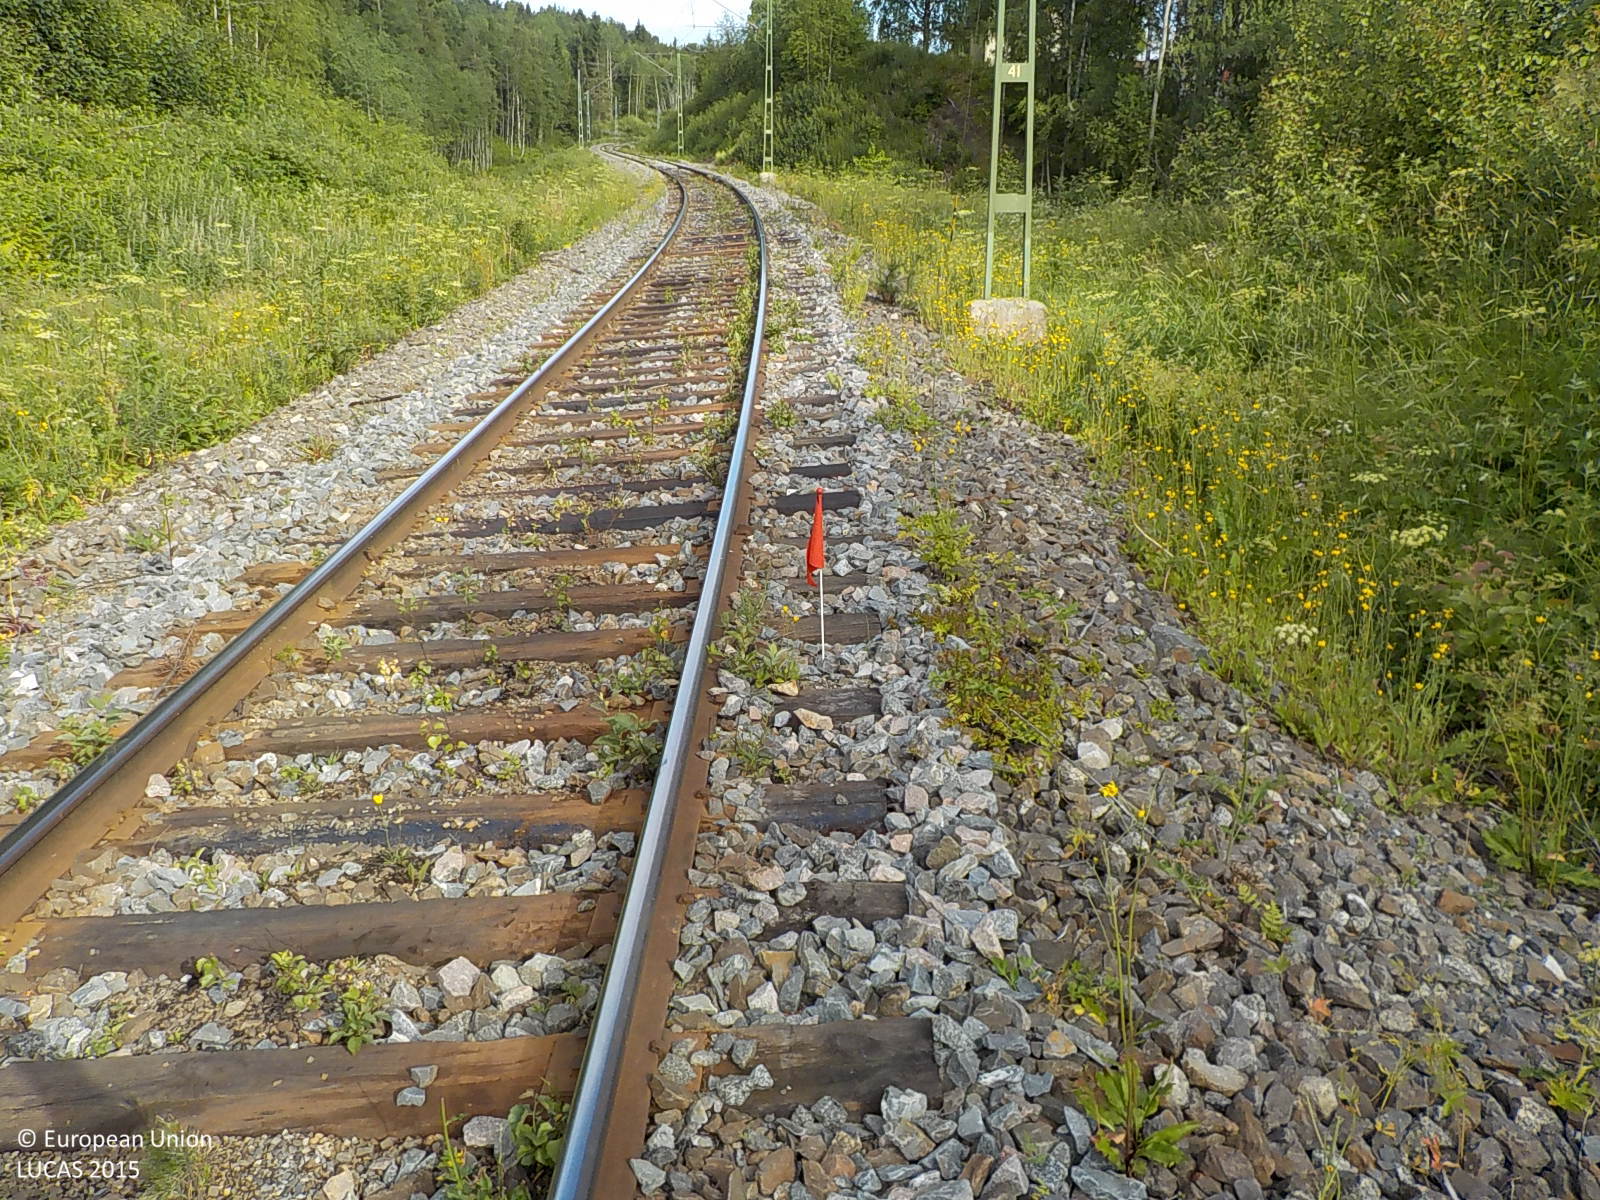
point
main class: Woodland
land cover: Broadleaved woodland
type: boreal forest
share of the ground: 50 - 75 %
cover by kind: broadleaved forest trees 50 %, herbaceous plants 50 %
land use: Forestry
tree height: < 5 m
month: July
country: SE
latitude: 63.1817
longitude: 17.2272
